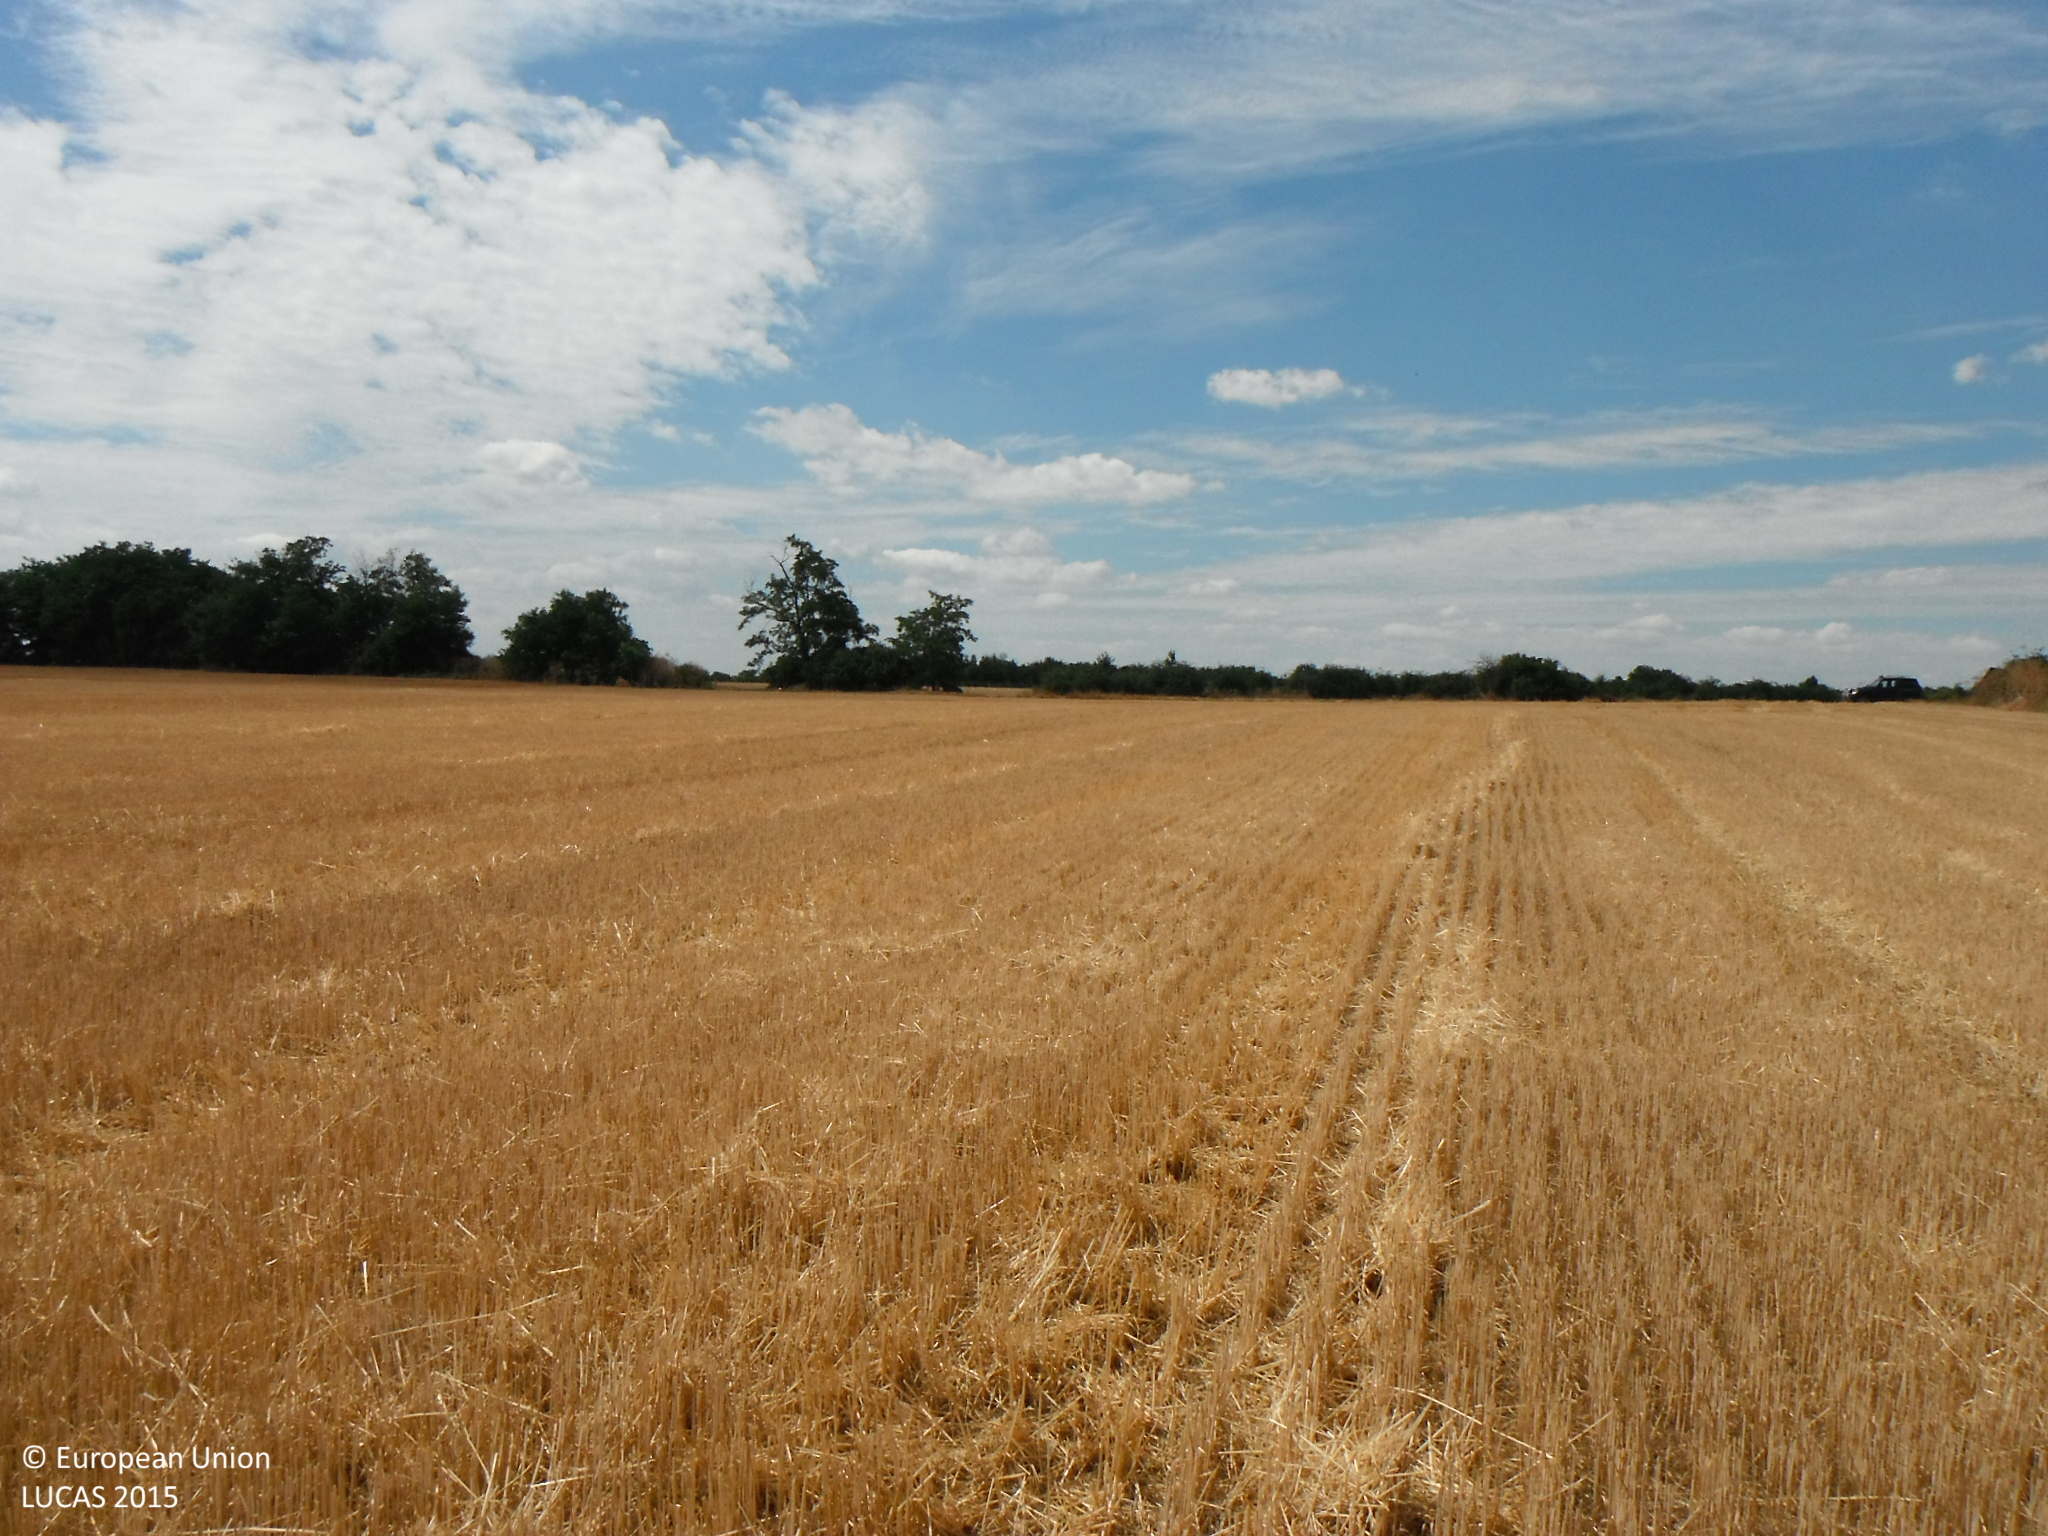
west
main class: Cropland
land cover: Common wheat
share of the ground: > 75 %
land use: Agriculture (excluding fallow land and kitchen gardens)
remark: Harvested field
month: July
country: SK
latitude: 48.1488
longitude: 18.2537
